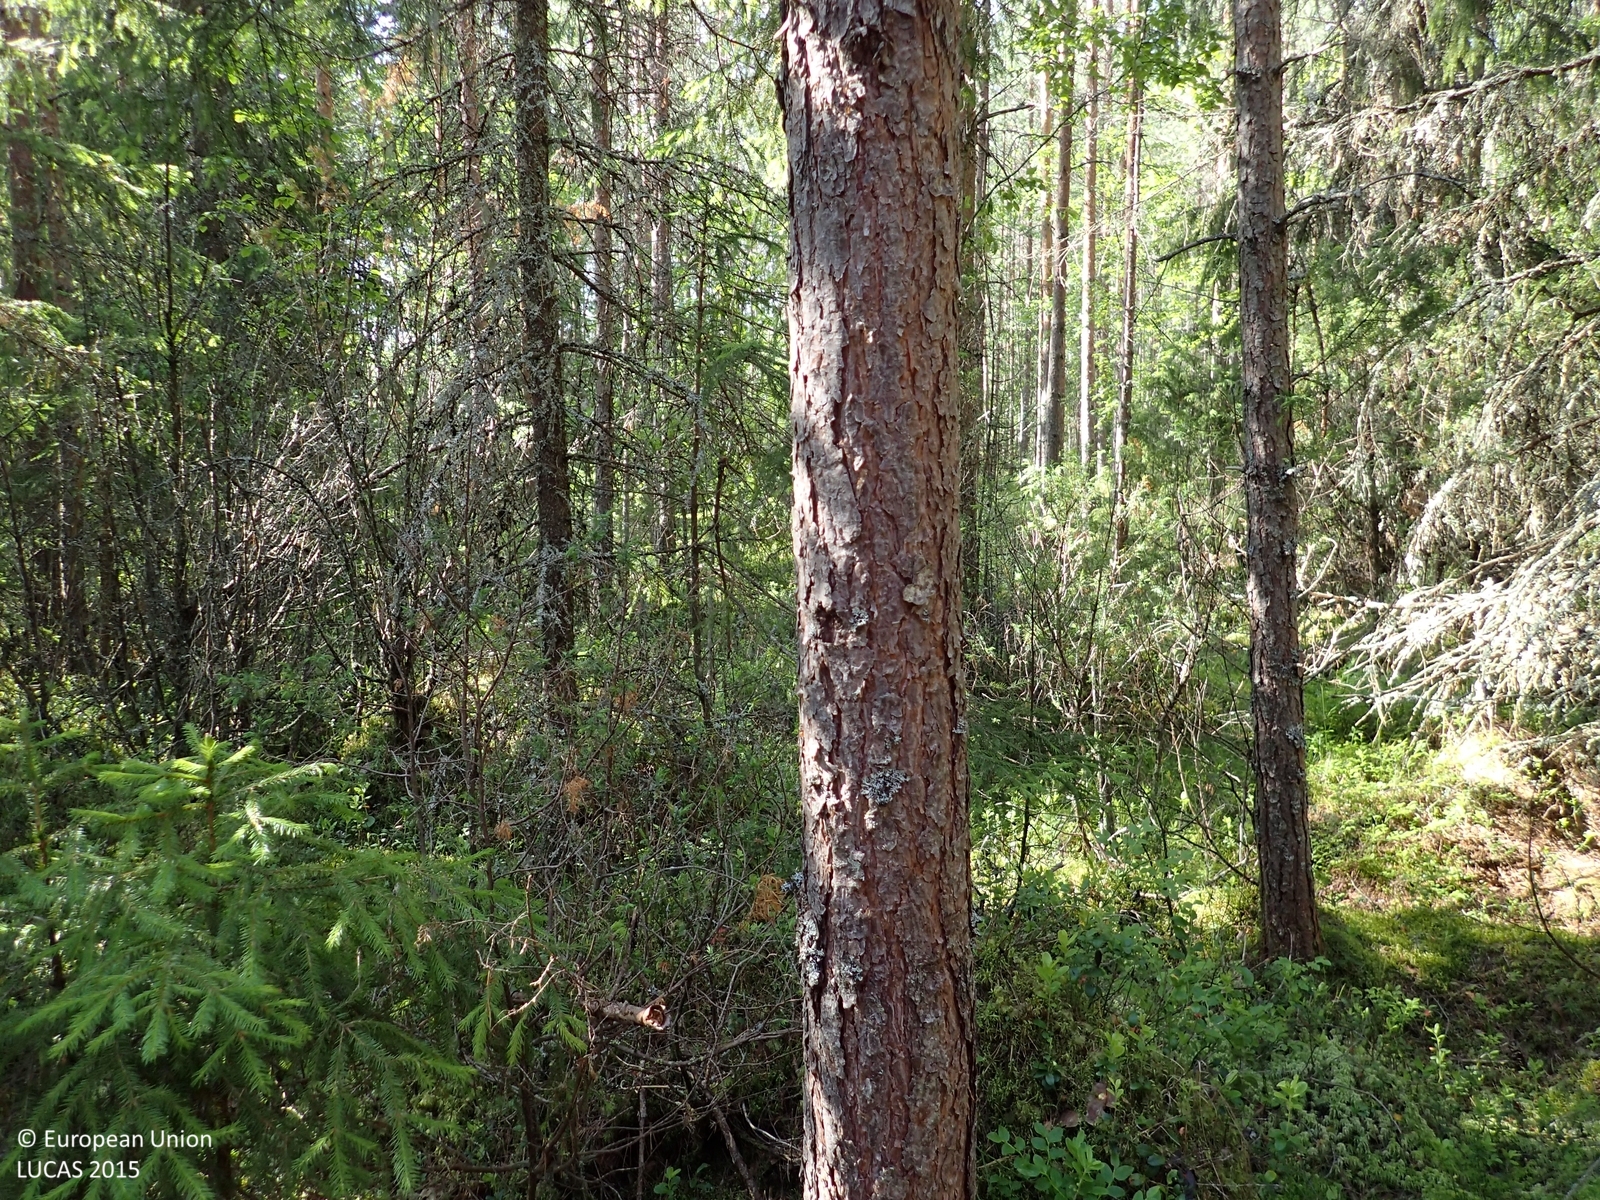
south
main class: Woodland
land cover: Other coniferous woodland
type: boreal forest
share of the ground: 50 - 75 %
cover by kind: coniferous forest trees 60 %, shrubs 35 %, lichens and mosses 5 %
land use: Forestry
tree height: > 5 m
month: July
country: FI
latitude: 62.7106
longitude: 21.5971
